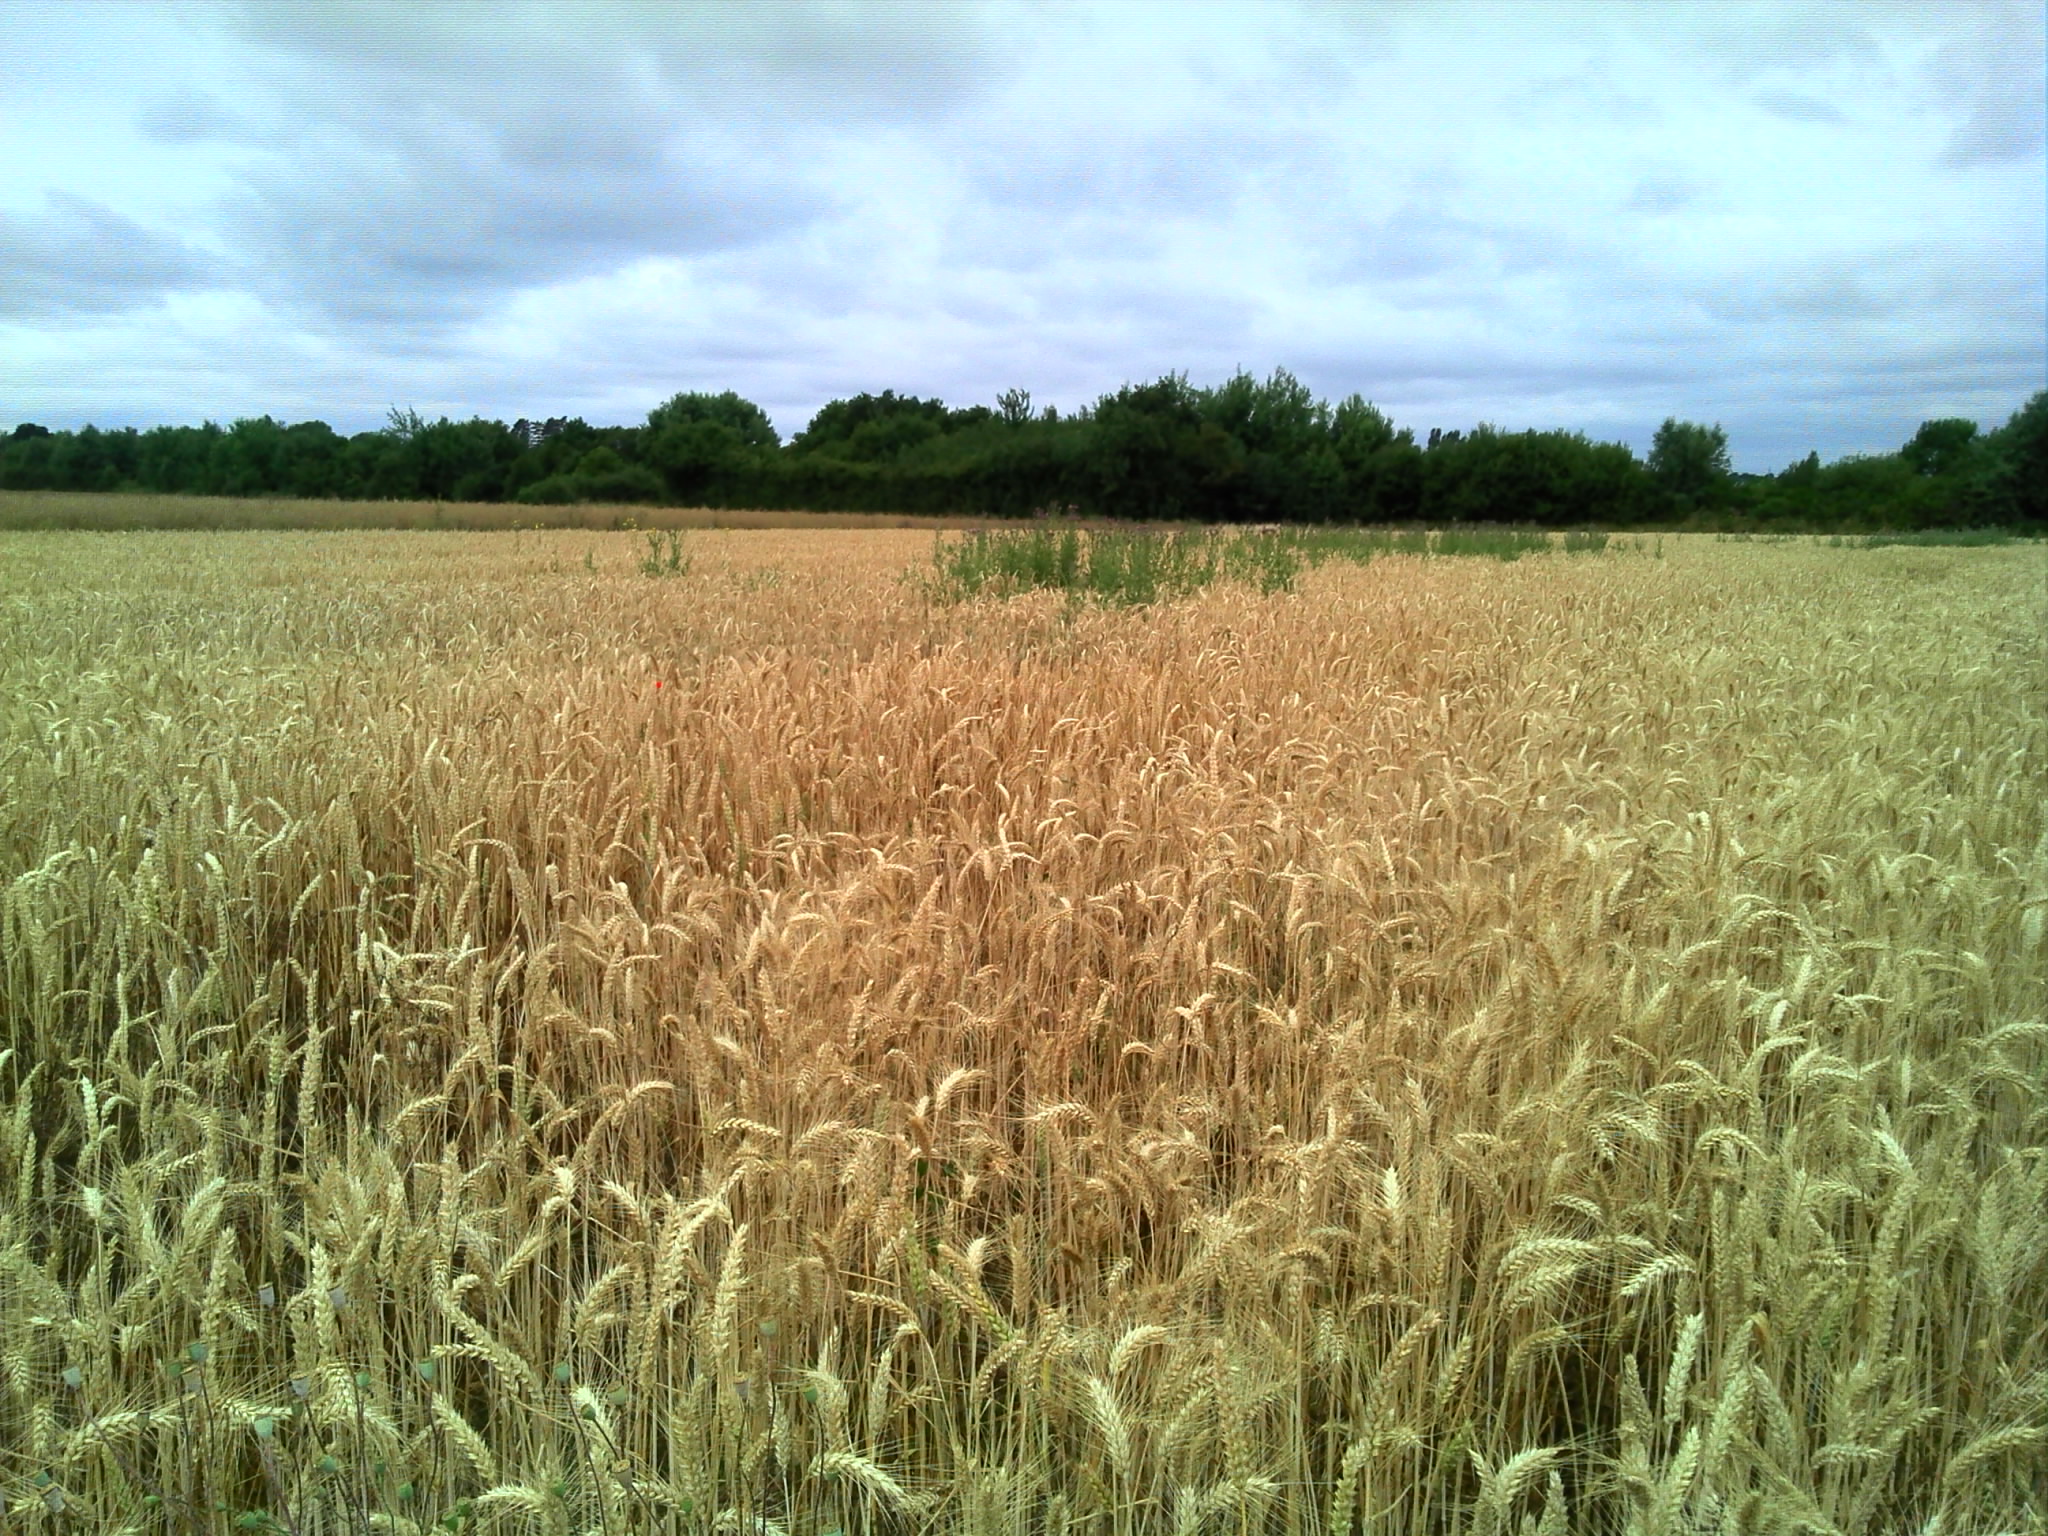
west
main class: Cropland
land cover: Common wheat
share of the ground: > 75 %
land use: Agriculture (excluding fallow land and kitchen gardens)
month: July
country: FR
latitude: 48.8280
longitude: 0.7272
